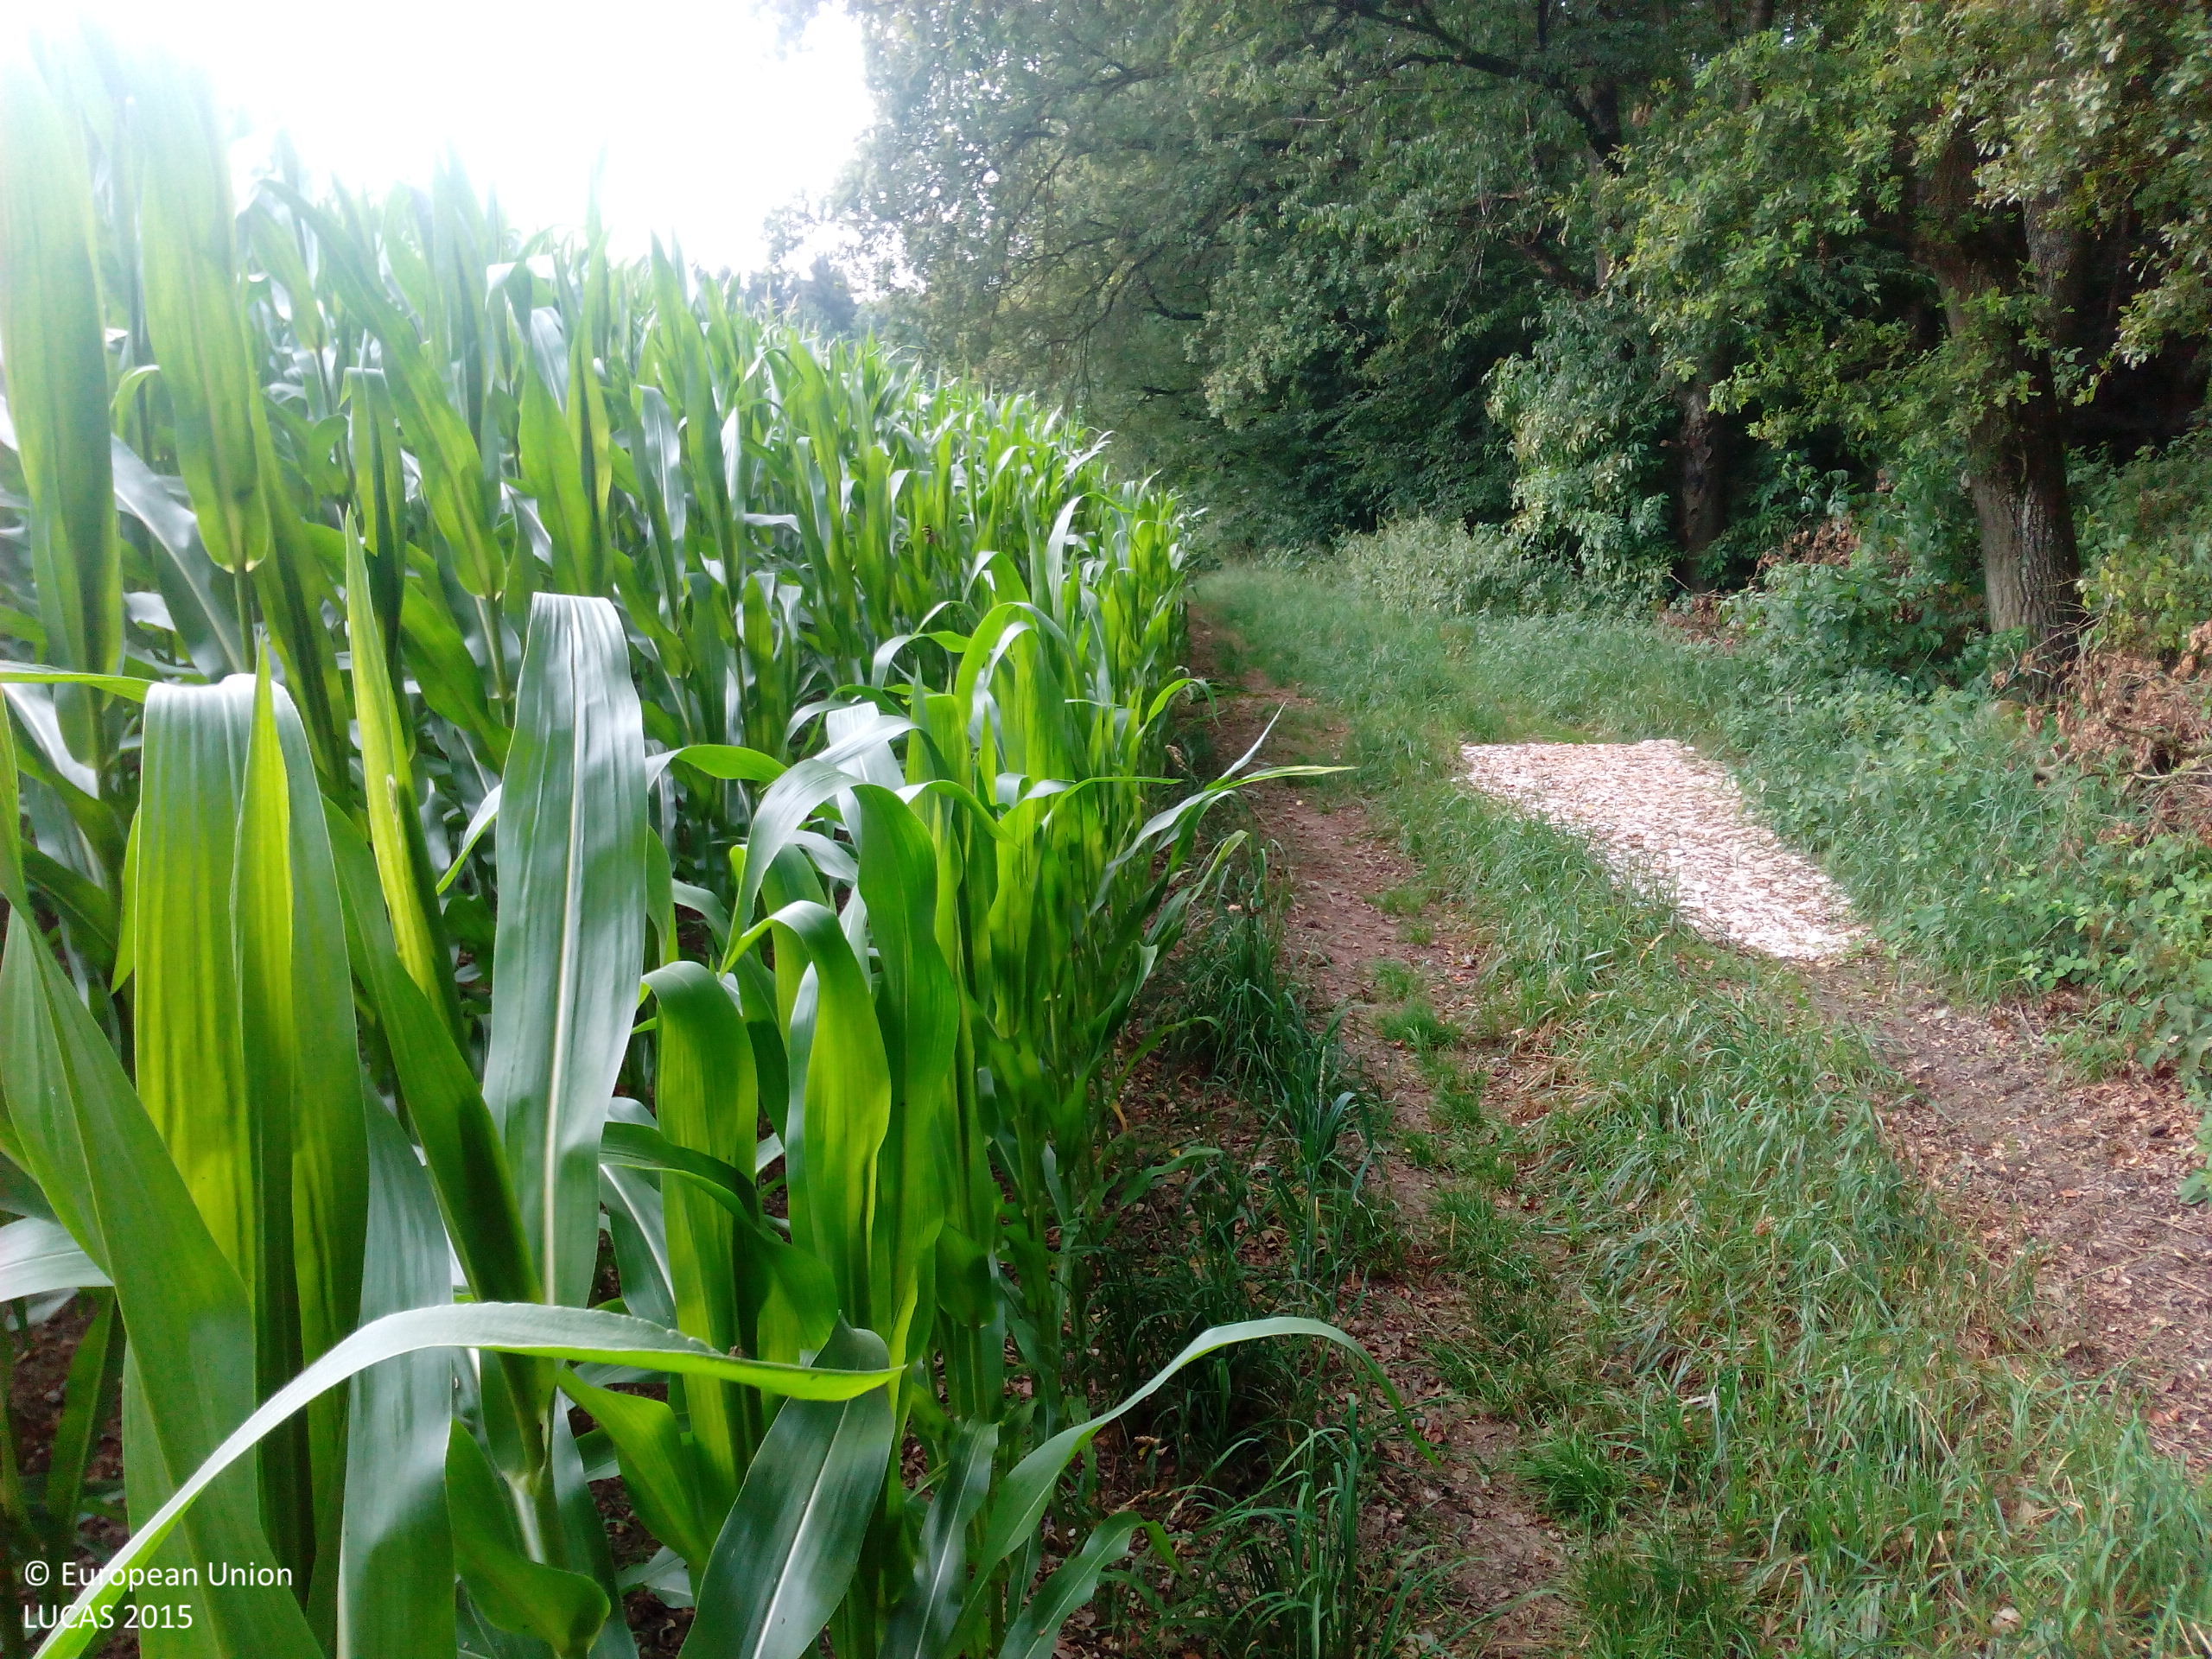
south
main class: Cropland
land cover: Maize
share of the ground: > 75 %
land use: Agriculture (excluding fallow land and kitchen gardens)
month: July
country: DE
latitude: 48.3115
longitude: 12.8981
